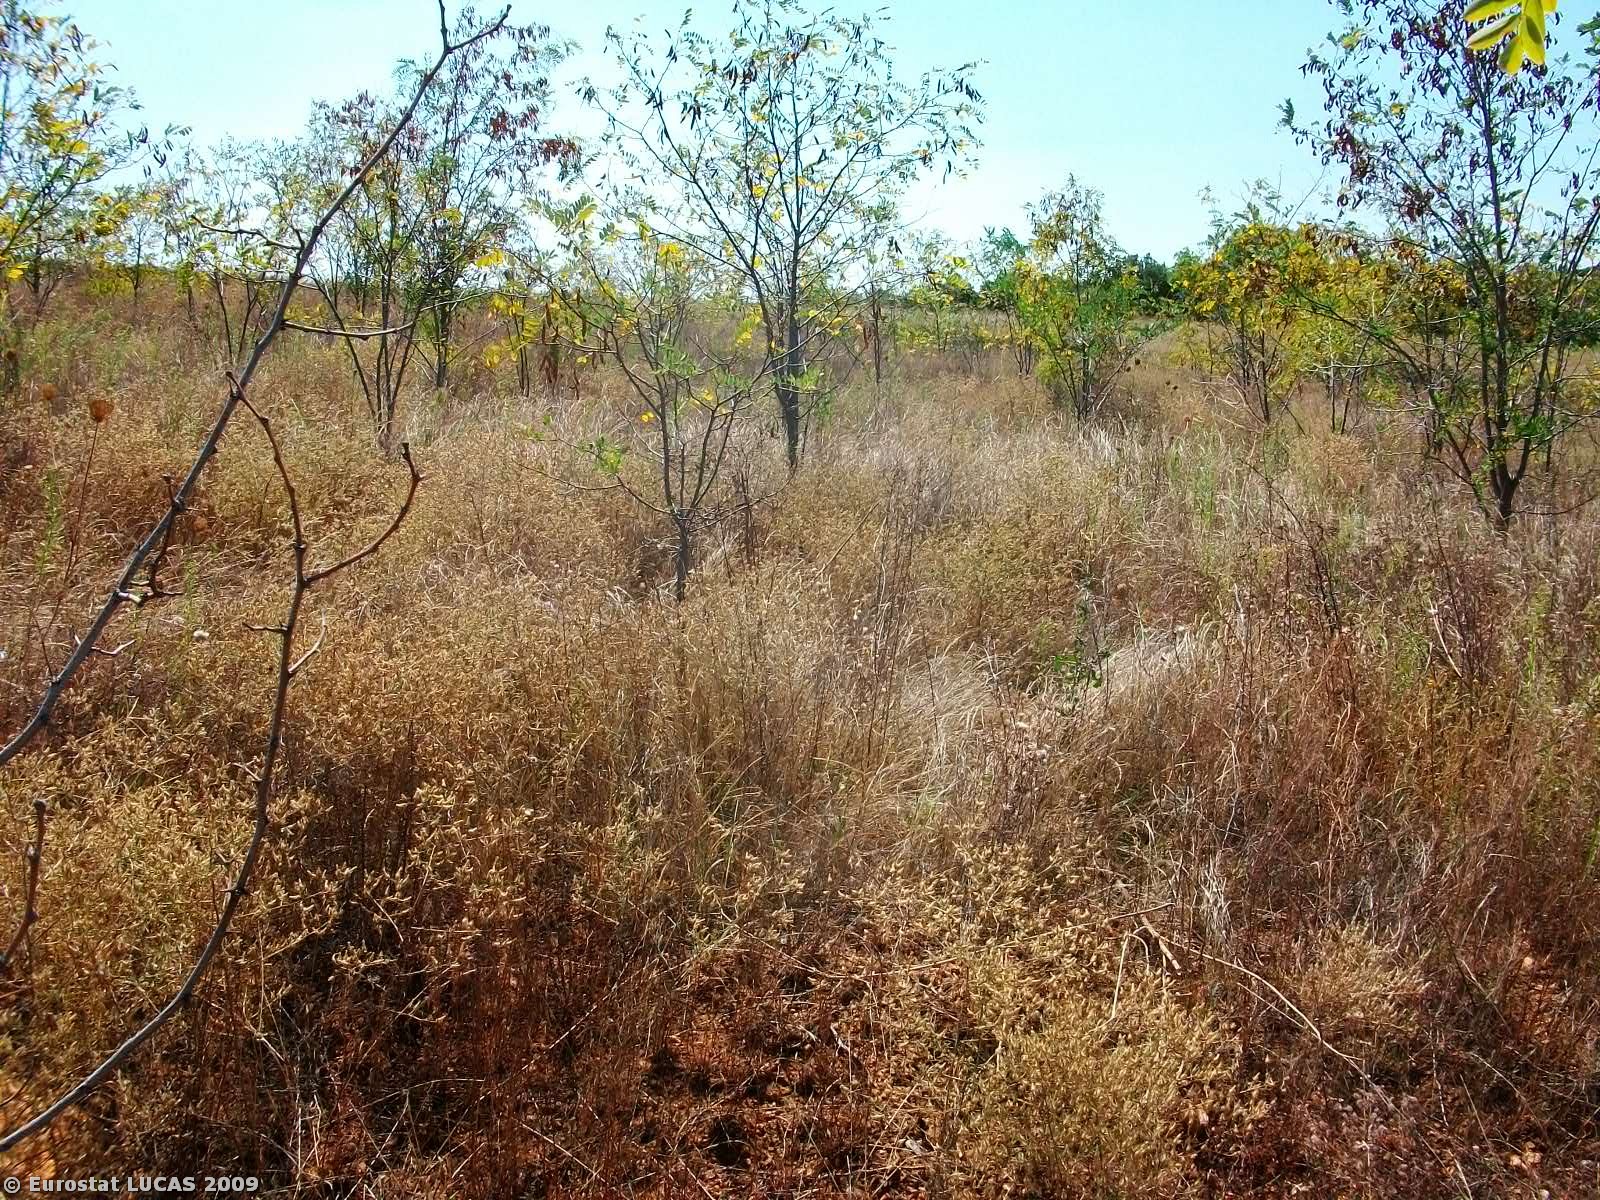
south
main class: Woodland
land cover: Broadleaved woodland
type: plantations and self-sown exotic forest
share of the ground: 25 - 50 %
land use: Forestry
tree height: > 5 m
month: September
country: GR
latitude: 41.3396
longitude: 26.3123
